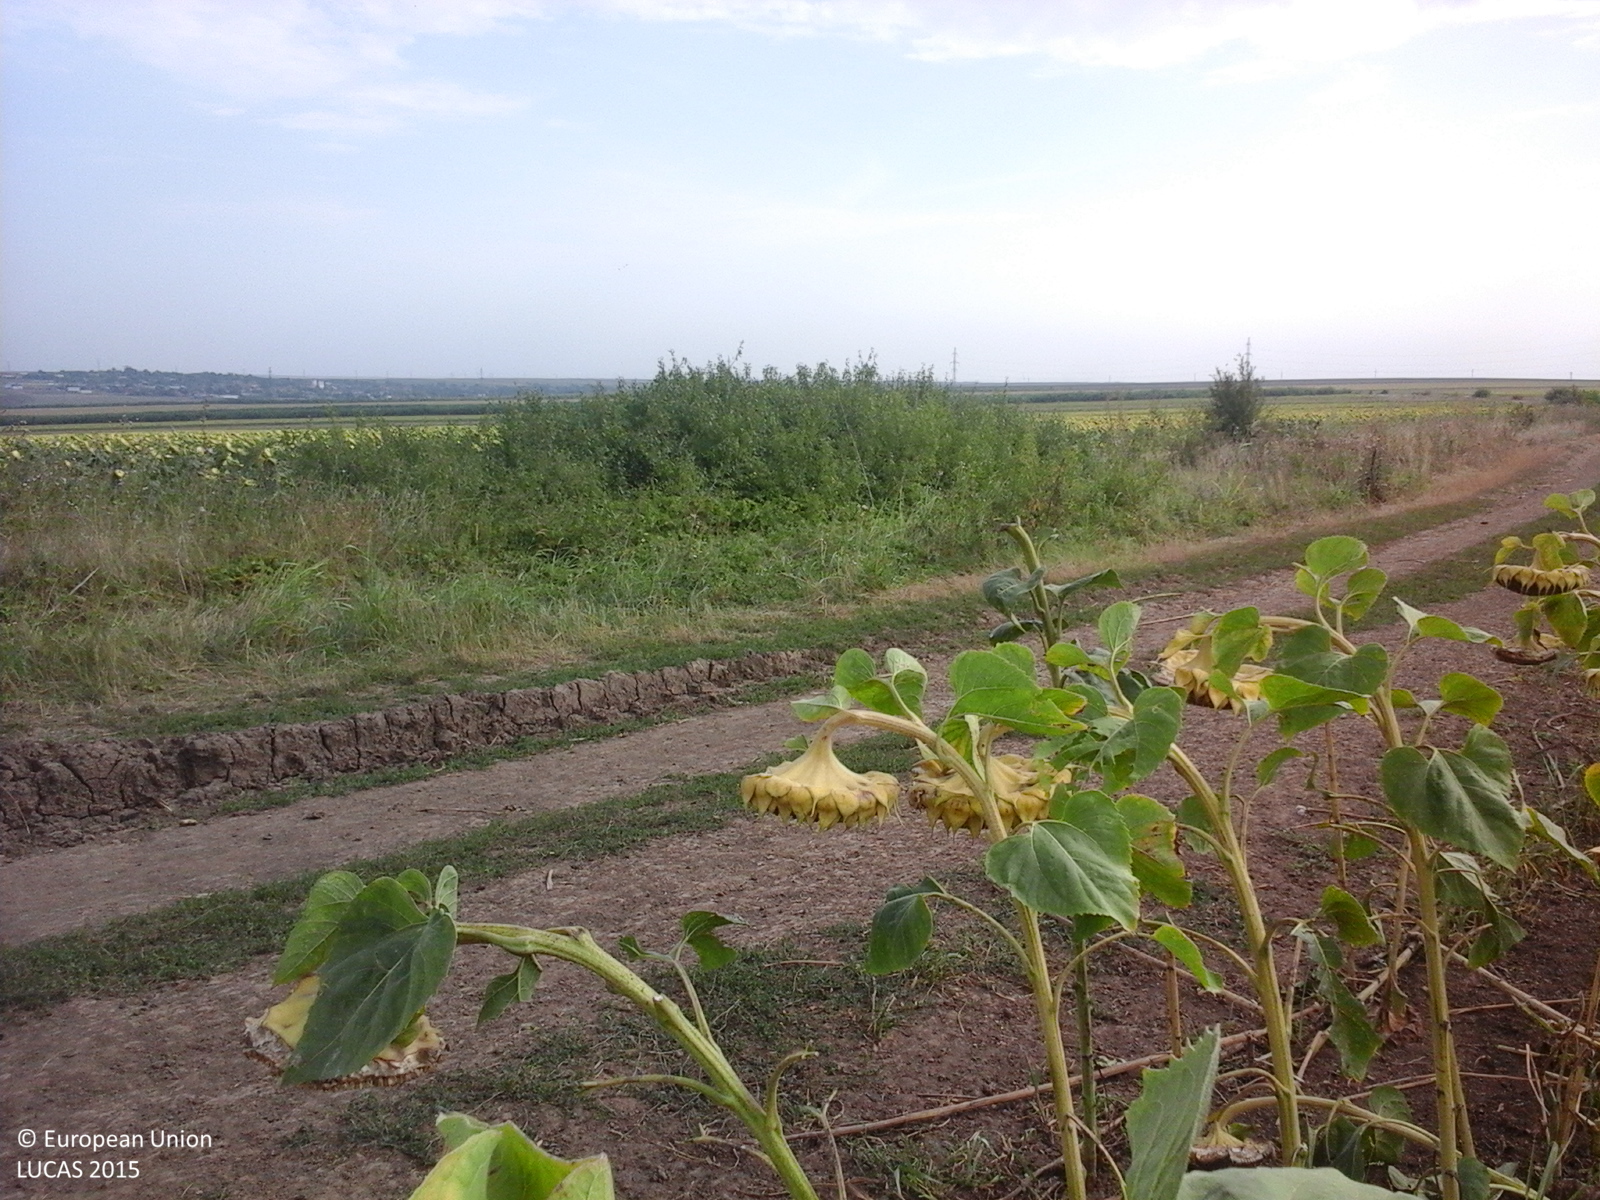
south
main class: Cropland
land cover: Sunflower
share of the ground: > 75 %
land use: Agriculture (excluding fallow land and kitchen gardens)
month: August
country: RO
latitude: 44.1932
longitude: 28.3442
